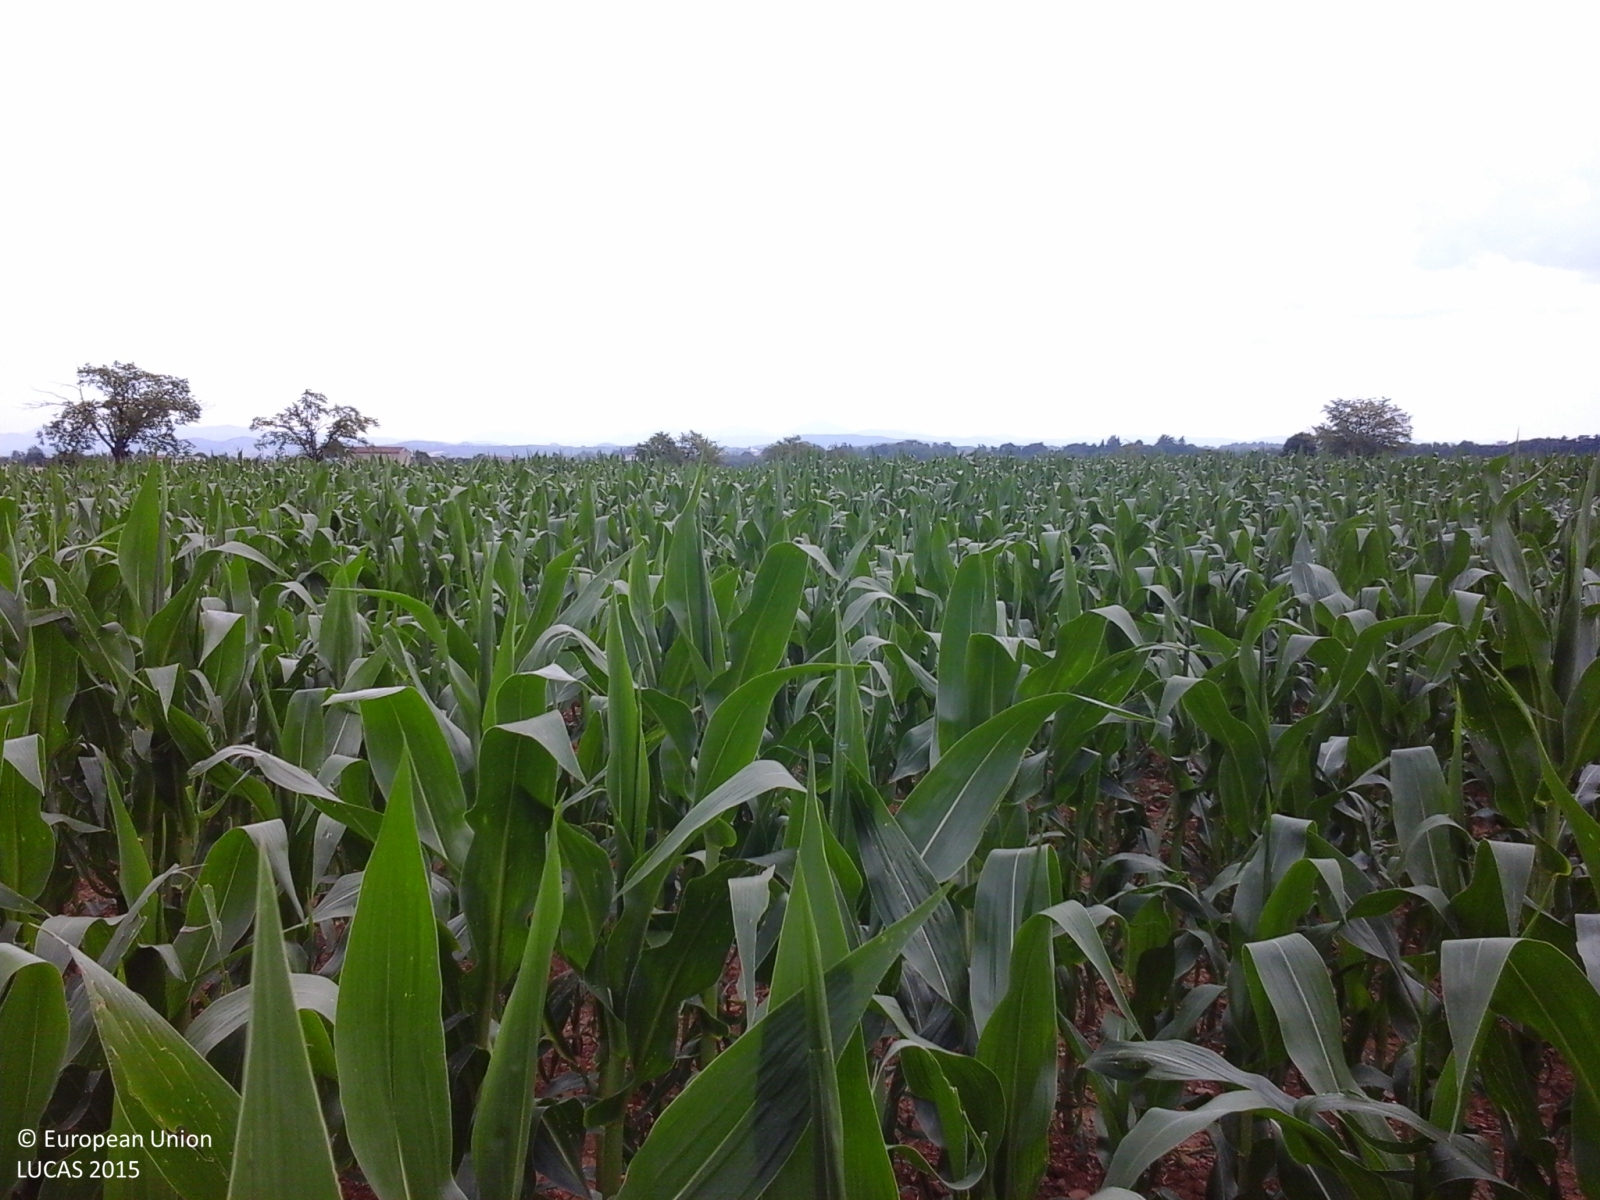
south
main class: Cropland
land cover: Maize
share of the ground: > 75 %
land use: Agriculture (excluding fallow land and kitchen gardens)
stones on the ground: 25 - 50 %
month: June
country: IT
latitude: 44.7945
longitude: 8.8016
